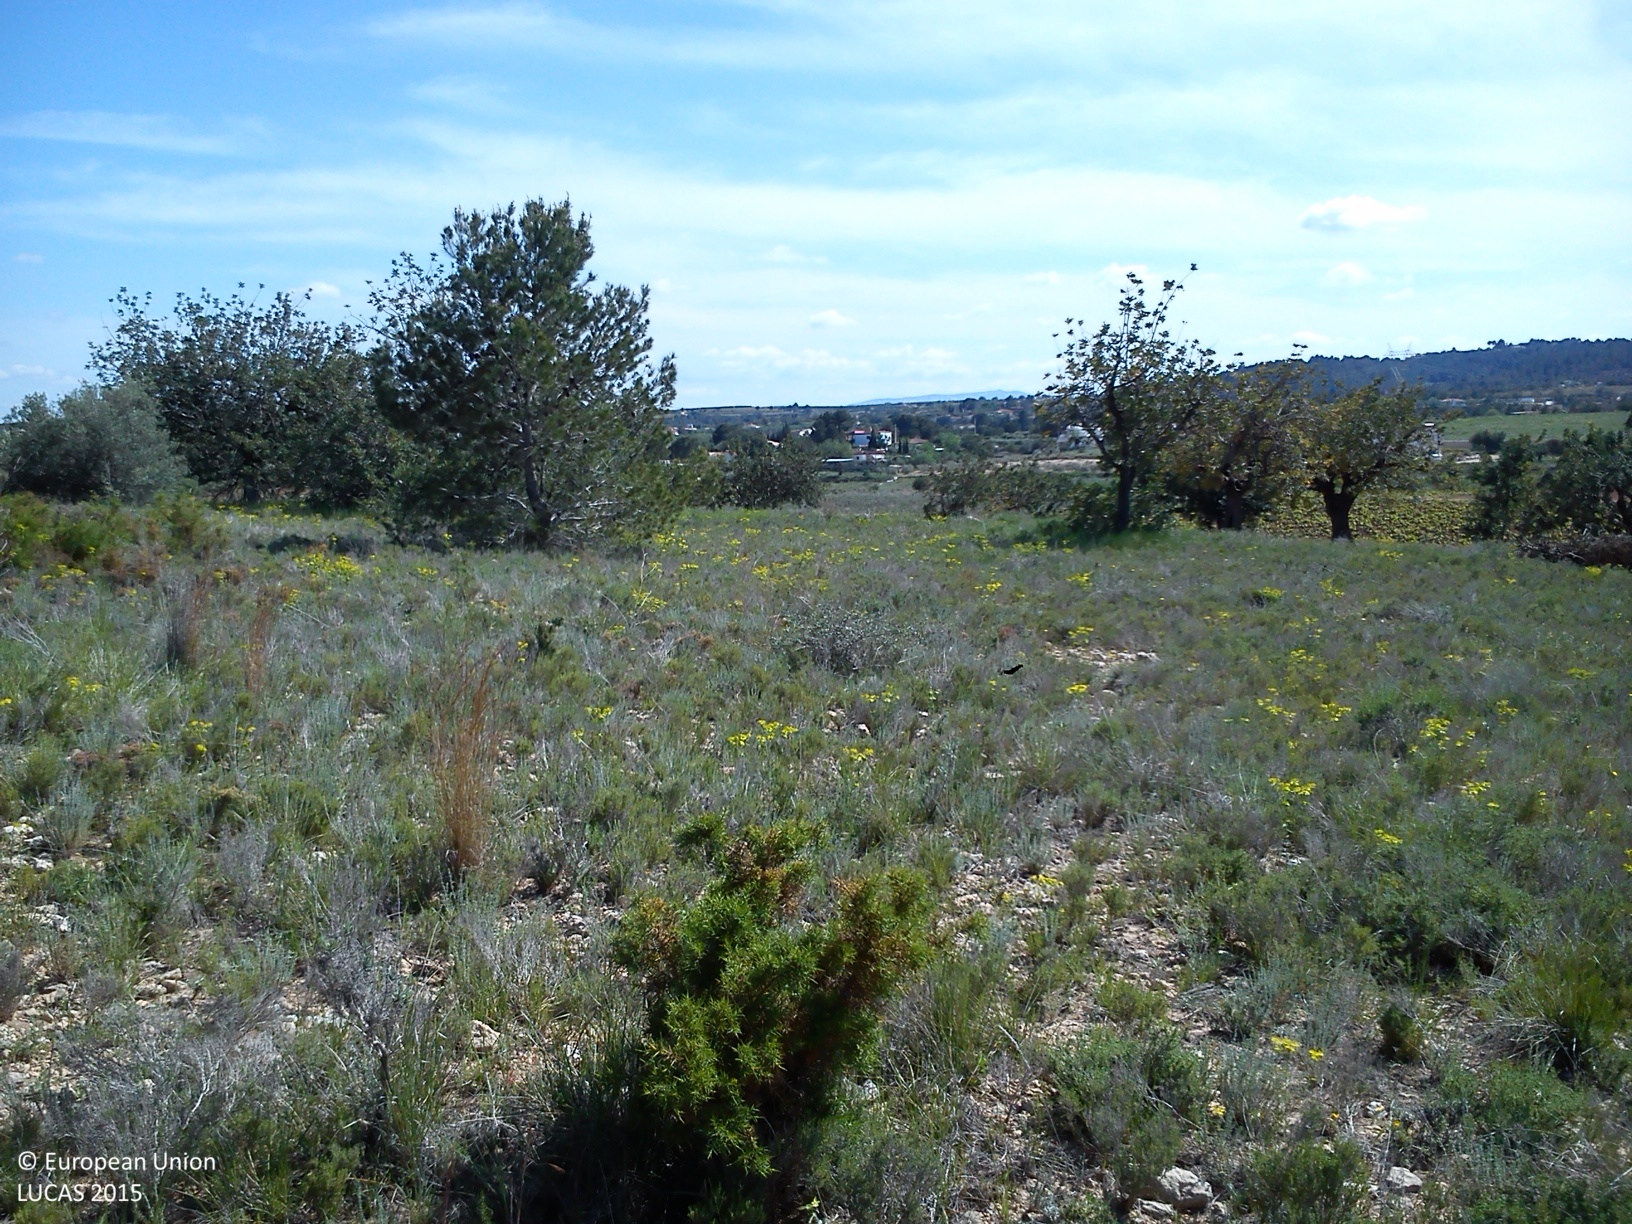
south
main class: Shrubland
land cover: Shrubland without tree cover
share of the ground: > 75 %
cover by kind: shrubs 55 %, herbaceous plants 30 %, consolidated bare surface 15 %
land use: Abandoned areas
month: April
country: ES
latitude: 39.4637
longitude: -0.6801
